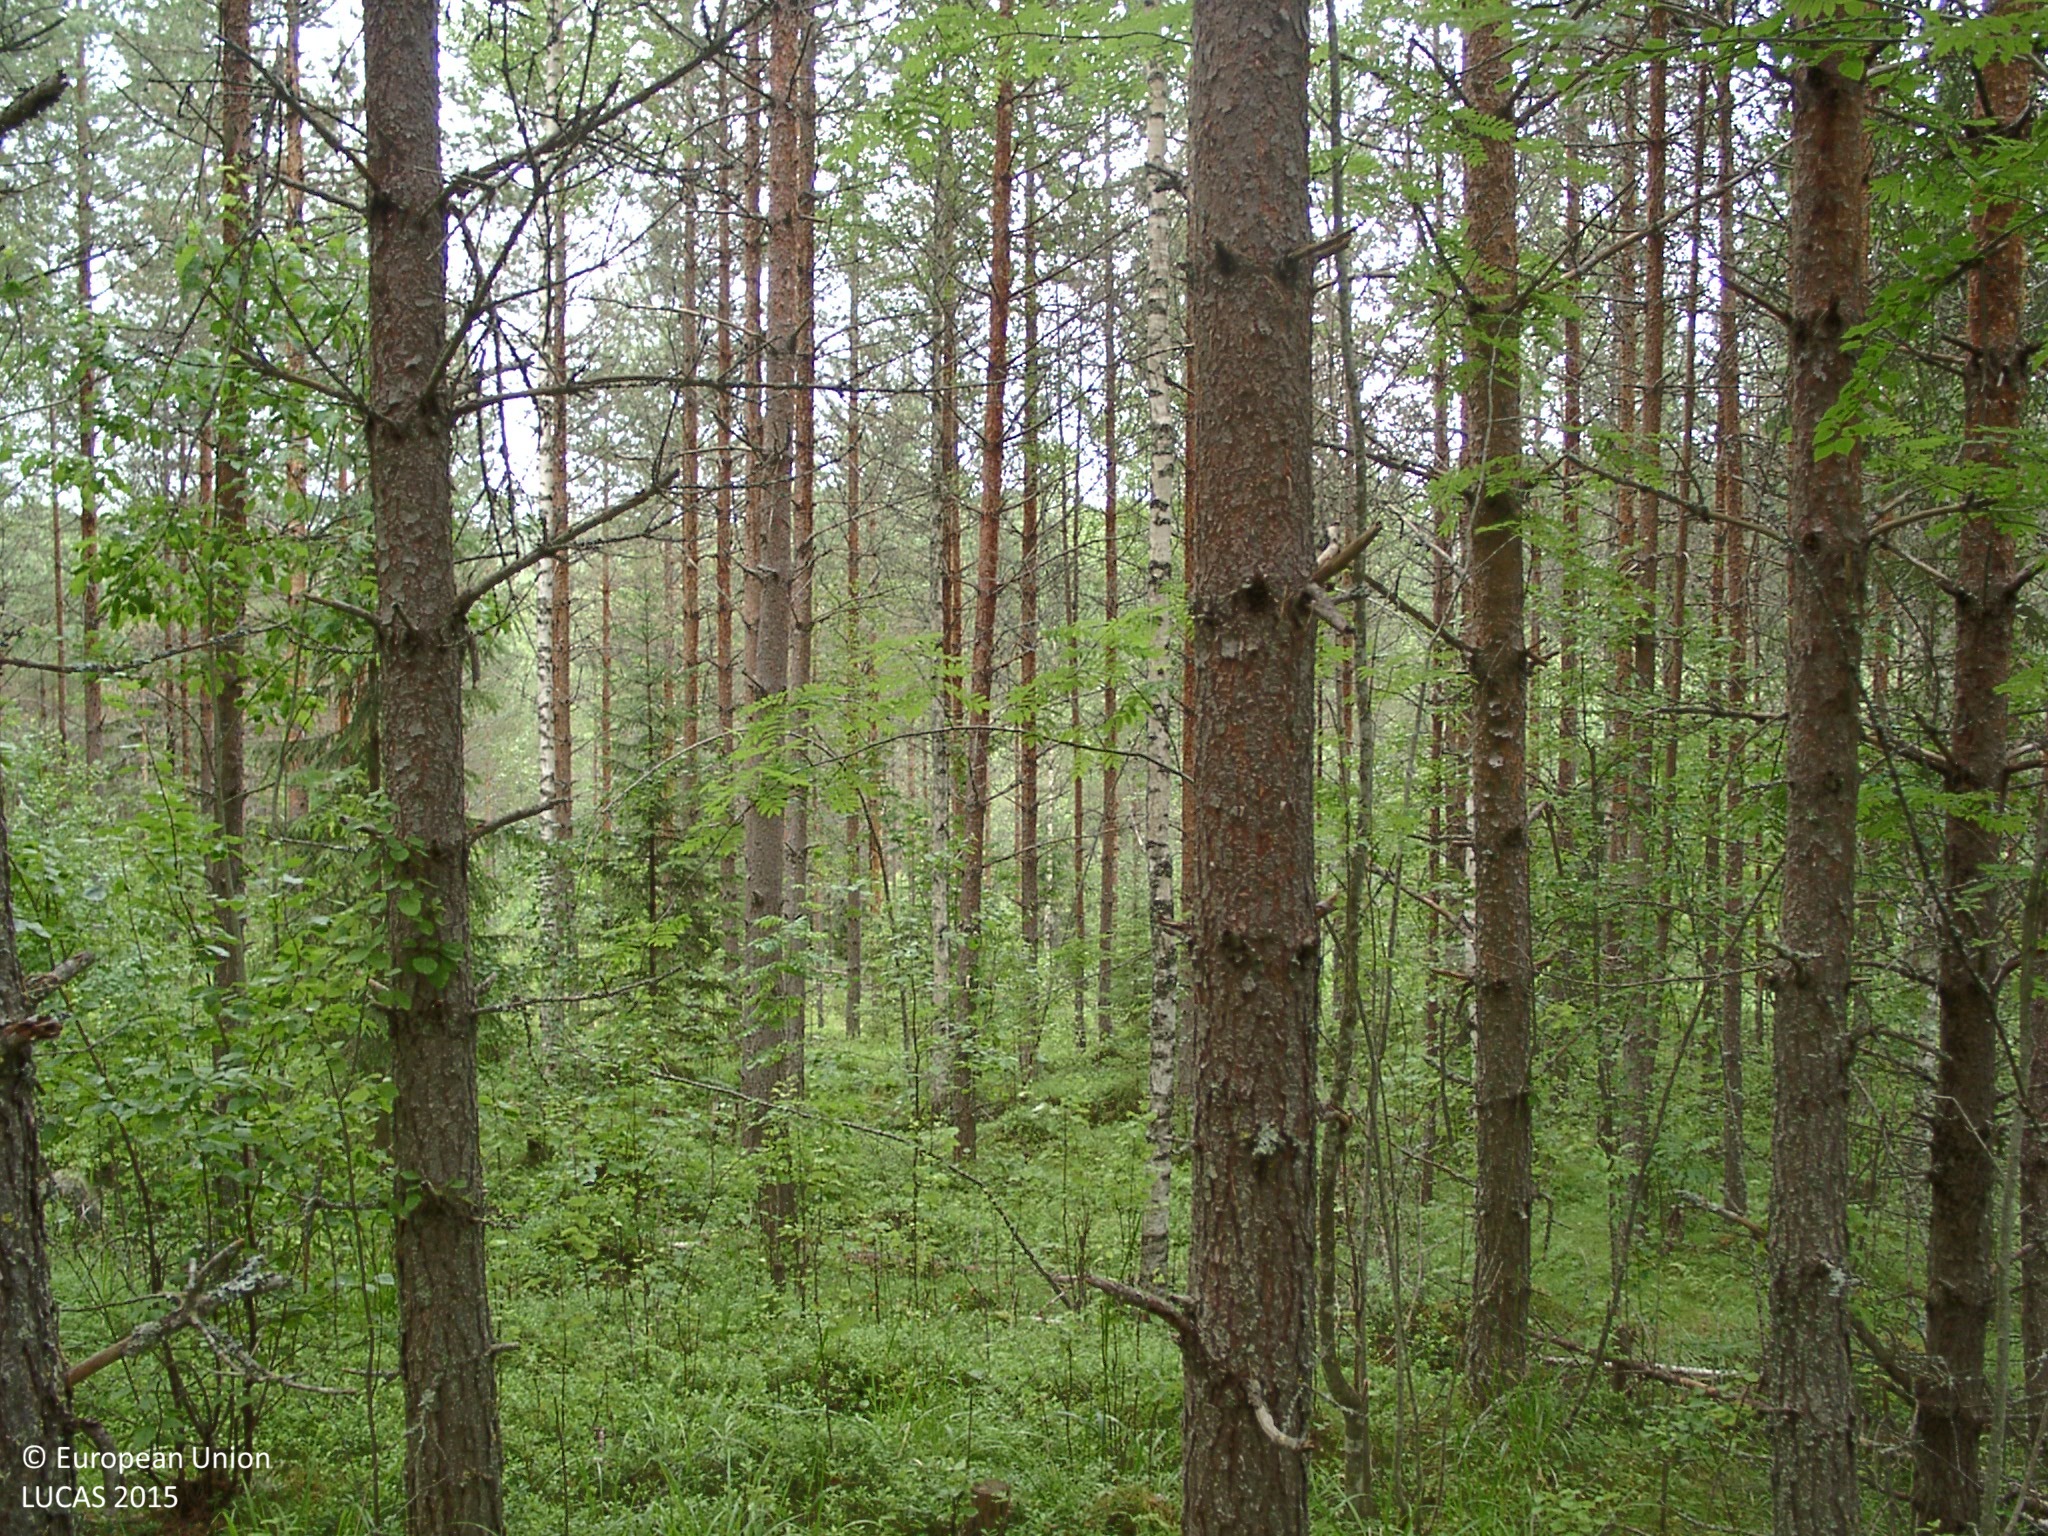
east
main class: Woodland
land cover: Pine dominated mixed woodland
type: boreal forest
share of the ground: 50 - 75 %
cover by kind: coniferous forest trees 45 %, broadleaved forest trees 25 %, shrubs 15 %, herbaceous plants 15 %
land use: Forestry
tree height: > 5 m
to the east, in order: Pine dominated mixed woodland; Shruby margins; Pine dominated mixed woodland; Shrubland with sparse tree cover; Electric lines; Tracks; Pine dominated coniferous woodland; Groves; Ditches and canals; Tracks; Spruce dominated mixed woodland; Other mixed woodland; Ditches and canals; Spruce dominated mixed woodland; Ditches and canals; Spruce dominated mixed woodland; Ditches and canals; Spruce dominated mixed woodland; Ditches and canals; Spruce dominated mixed woodland; Groves; Ditches and canals; Spruce dominated mixed woodland; Grassland with sparse tree/shrub cover; Fences; Grassland without tree/shrub cover; Ditches and canals; Groves
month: July
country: FI
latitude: 62.1134
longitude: 25.3481
